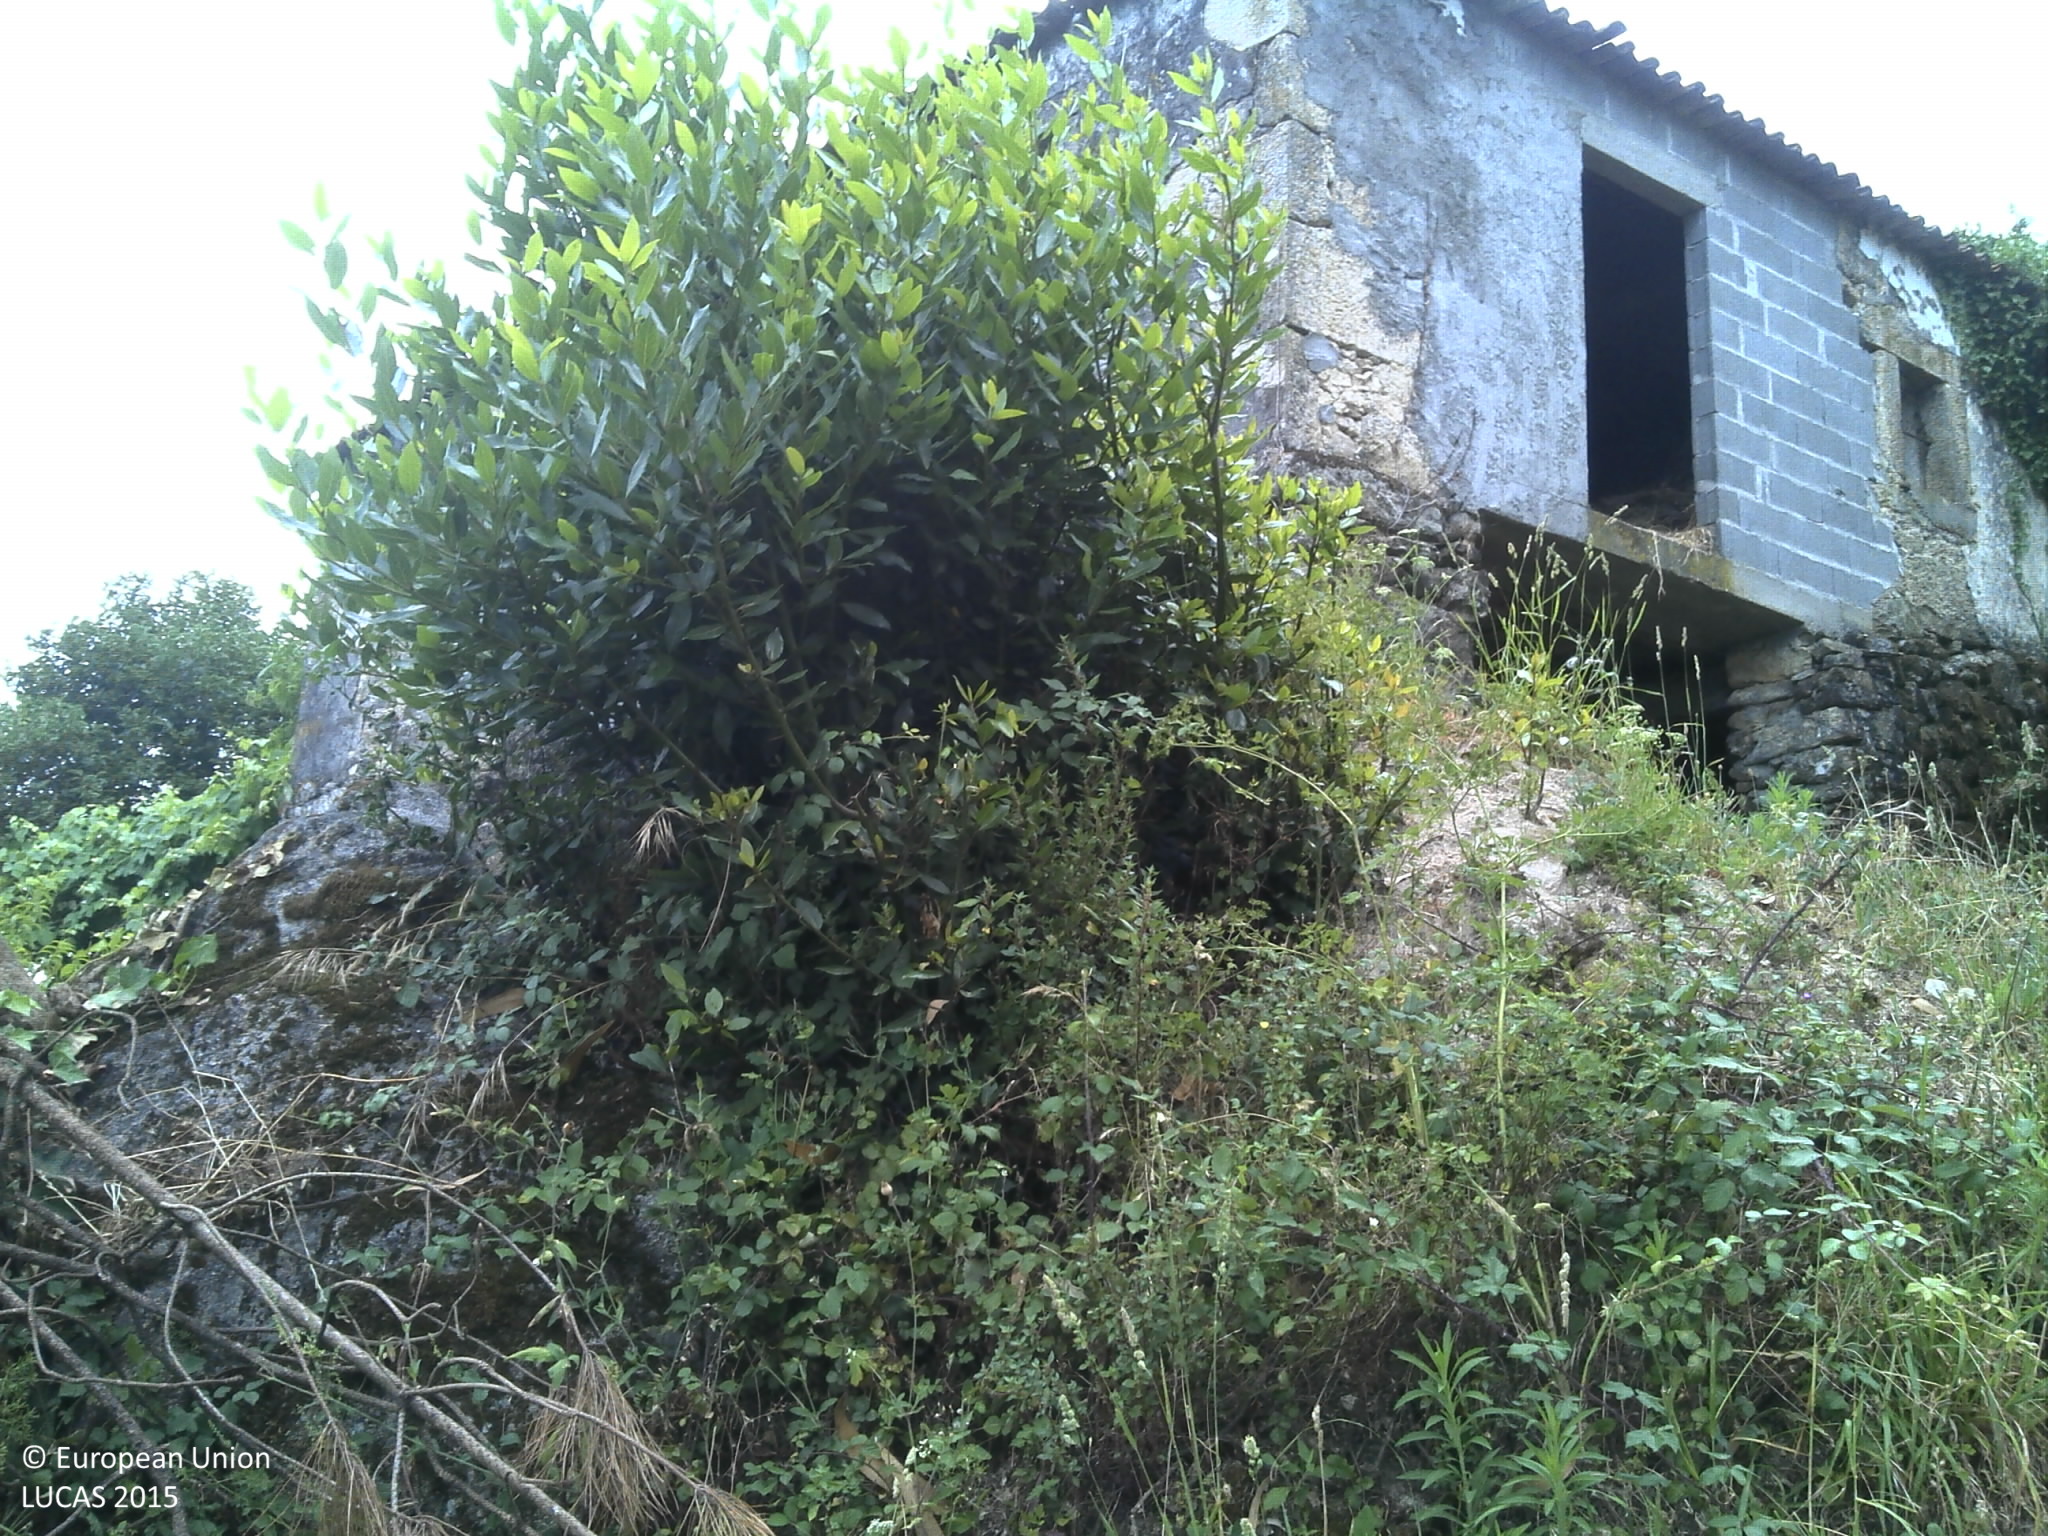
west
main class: Grassland
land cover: Grassland without tree/shrub cover
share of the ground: 50 - 75 %
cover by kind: herbaceous plants 75 %, unconsolidated bare surface 25 %
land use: Agriculture (excluding fallow land and kitchen gardens)
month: June
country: PT
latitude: 40.7844
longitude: -8.3033
